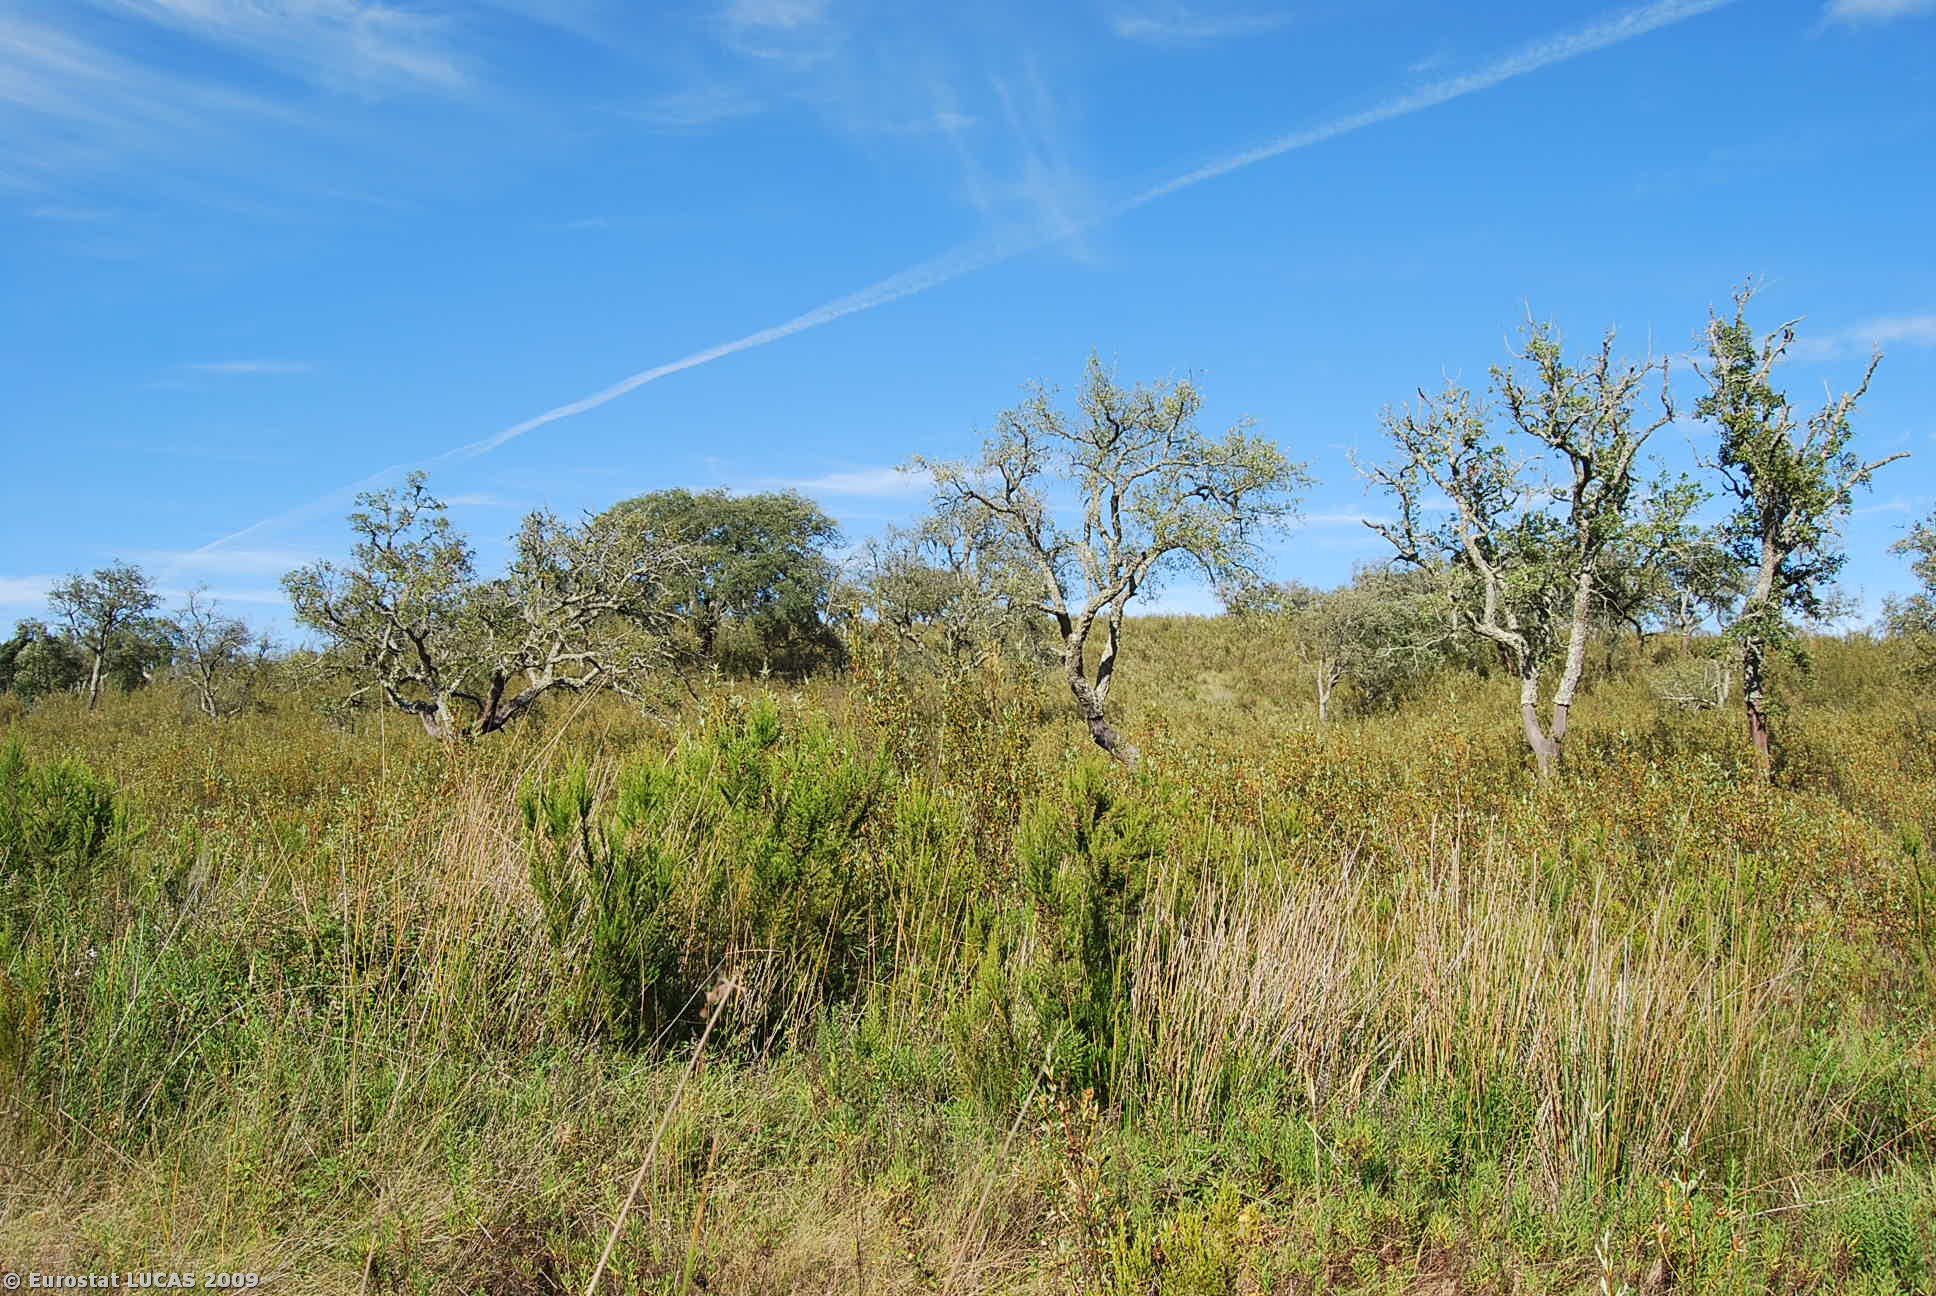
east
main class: Shrubland
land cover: Shrubland with sparse tree cover
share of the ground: > 75 %
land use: Unused
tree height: > 5 m
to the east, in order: Shrubland with sparse tree cover; Tracks; Shrubland with sparse tree cover; Broadleaved woodland; Tracks; Broadleaved woodland; Shrubland with sparse tree cover
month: June
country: PT
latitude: 37.9511
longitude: -8.6996
